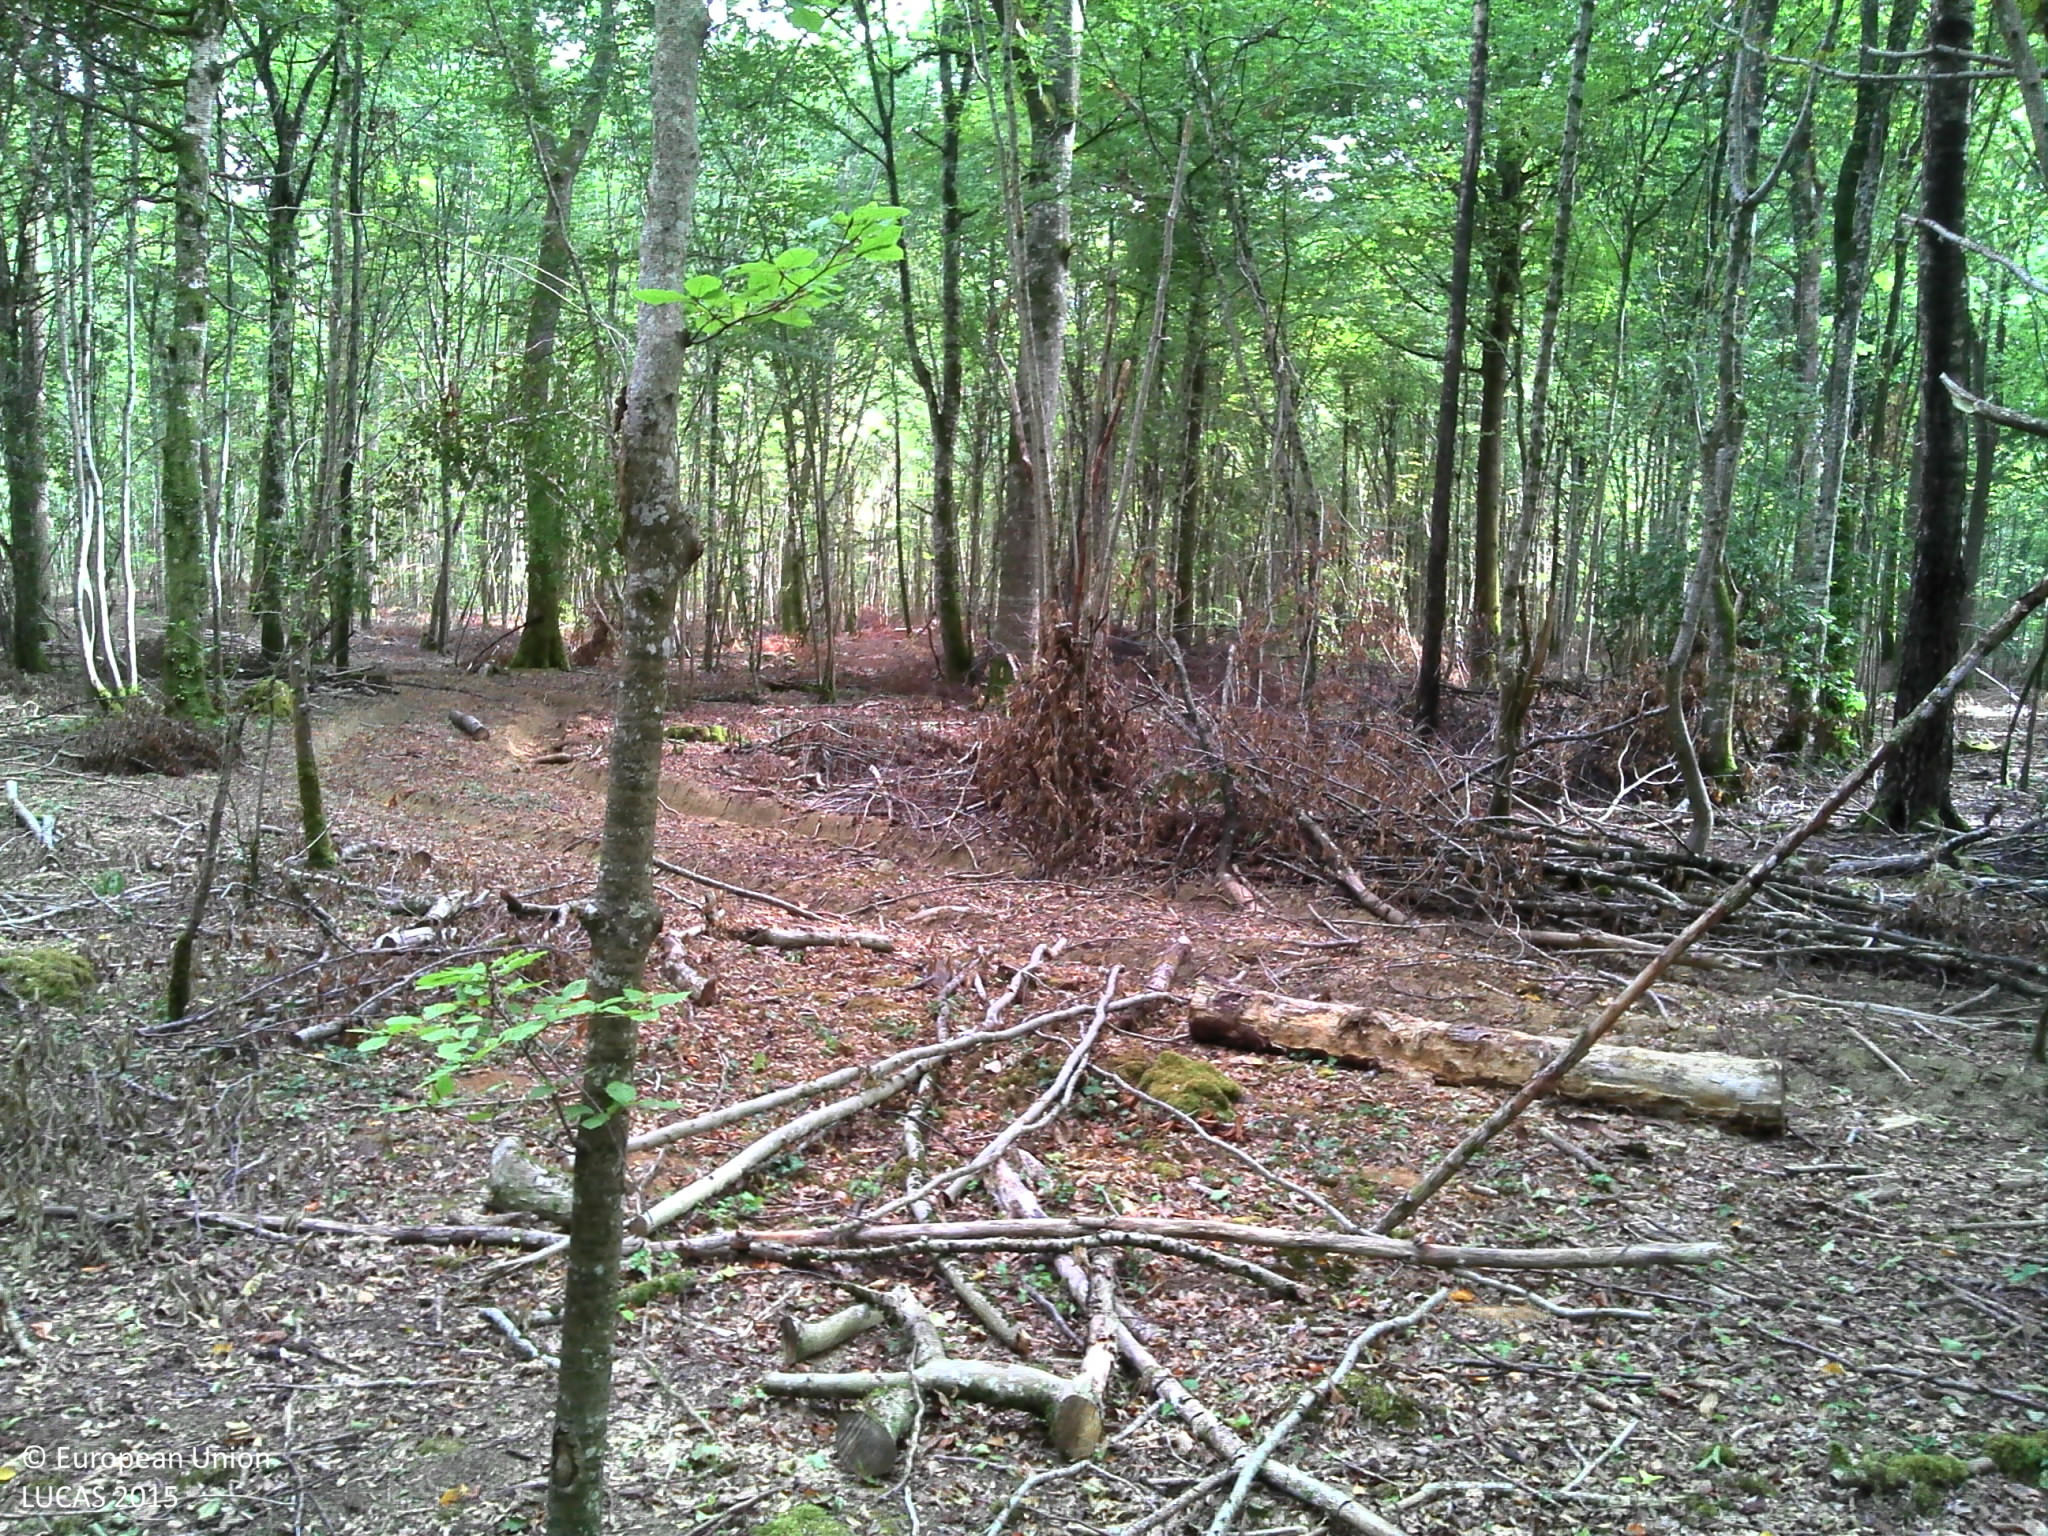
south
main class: Woodland
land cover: Broadleaved woodland
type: mesophytic deciduous forest
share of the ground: > 75 %
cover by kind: broadleaved forest trees 85 %, herbaceous plants 5 %, lichens and mosses 5 %, consolidated bare surface 5 %
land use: Forestry
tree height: > 5 m
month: August
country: FR
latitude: 47.6998
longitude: 4.7088
